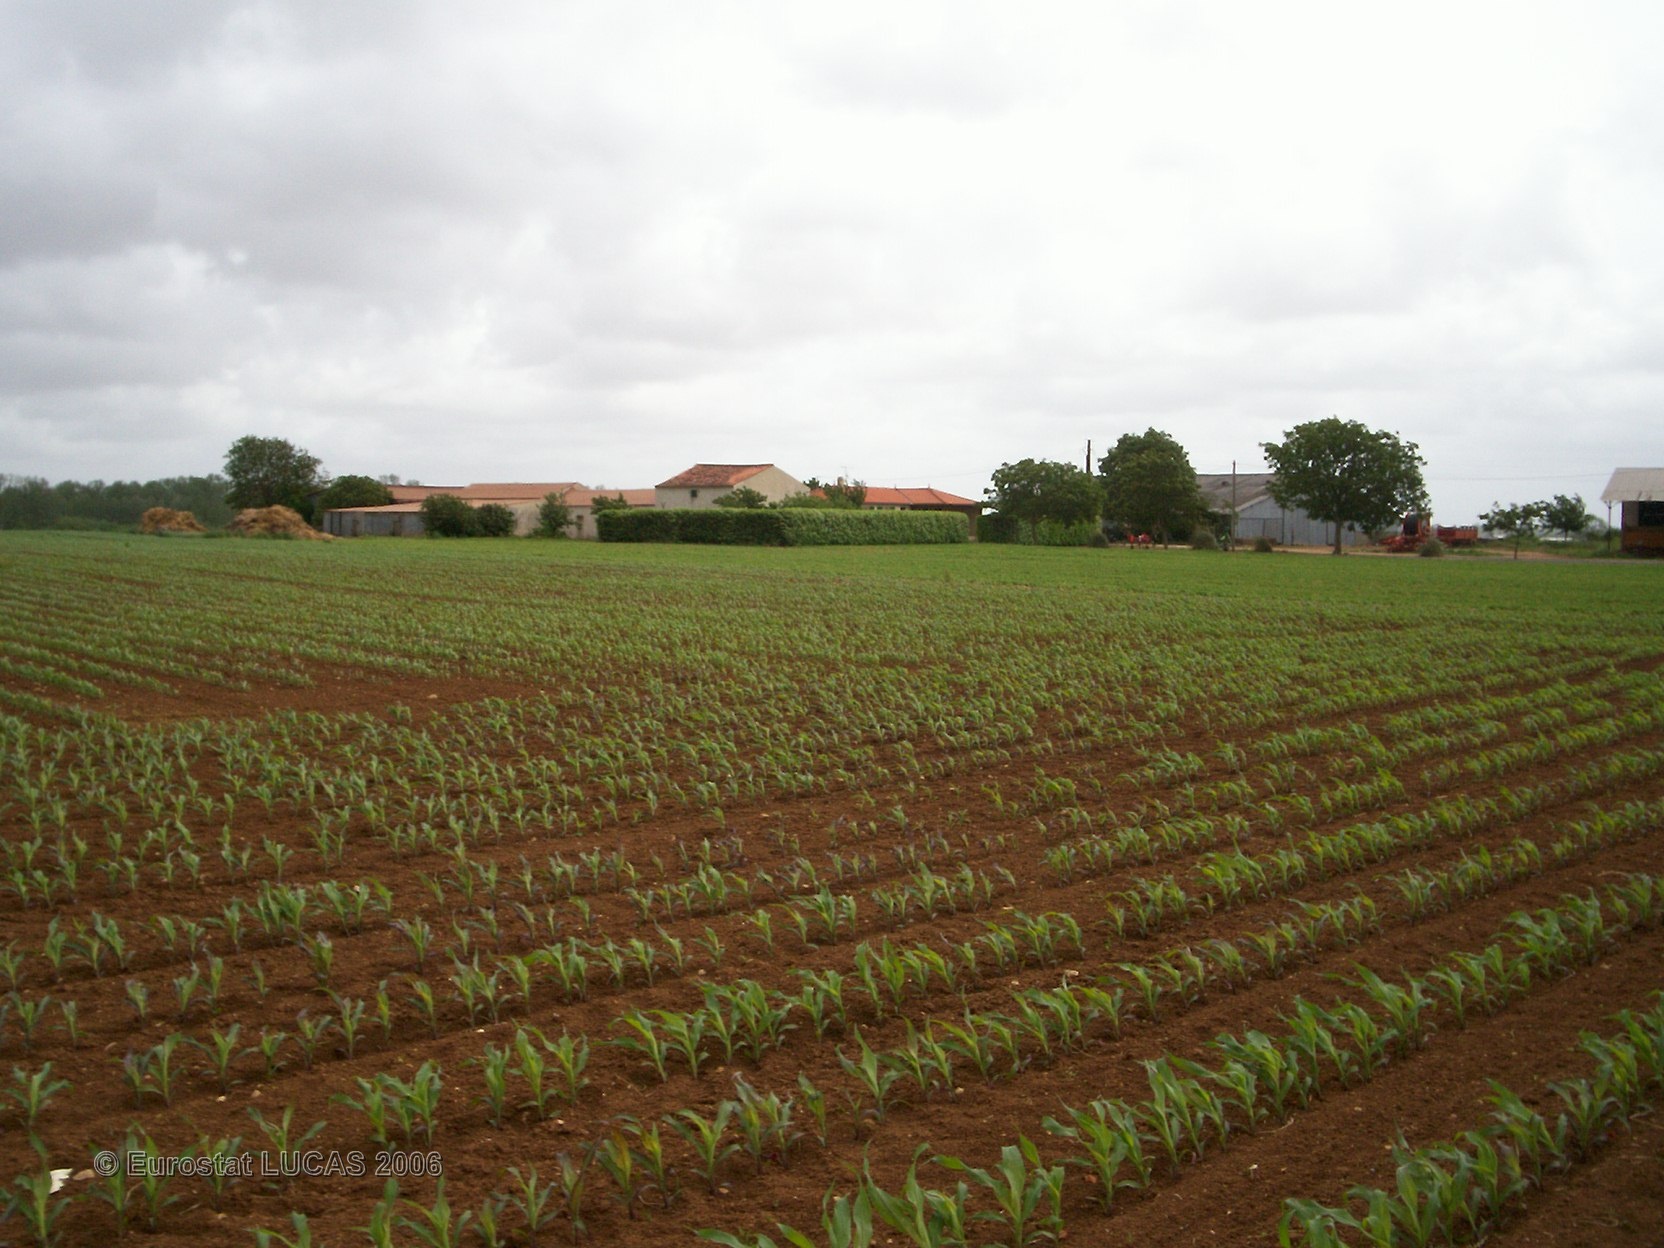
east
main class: Cropland
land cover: Maize
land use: Agriculture (excluding fallow land and kitchen gardens)
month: May
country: FR
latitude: 46.4009
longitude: -0.8118
